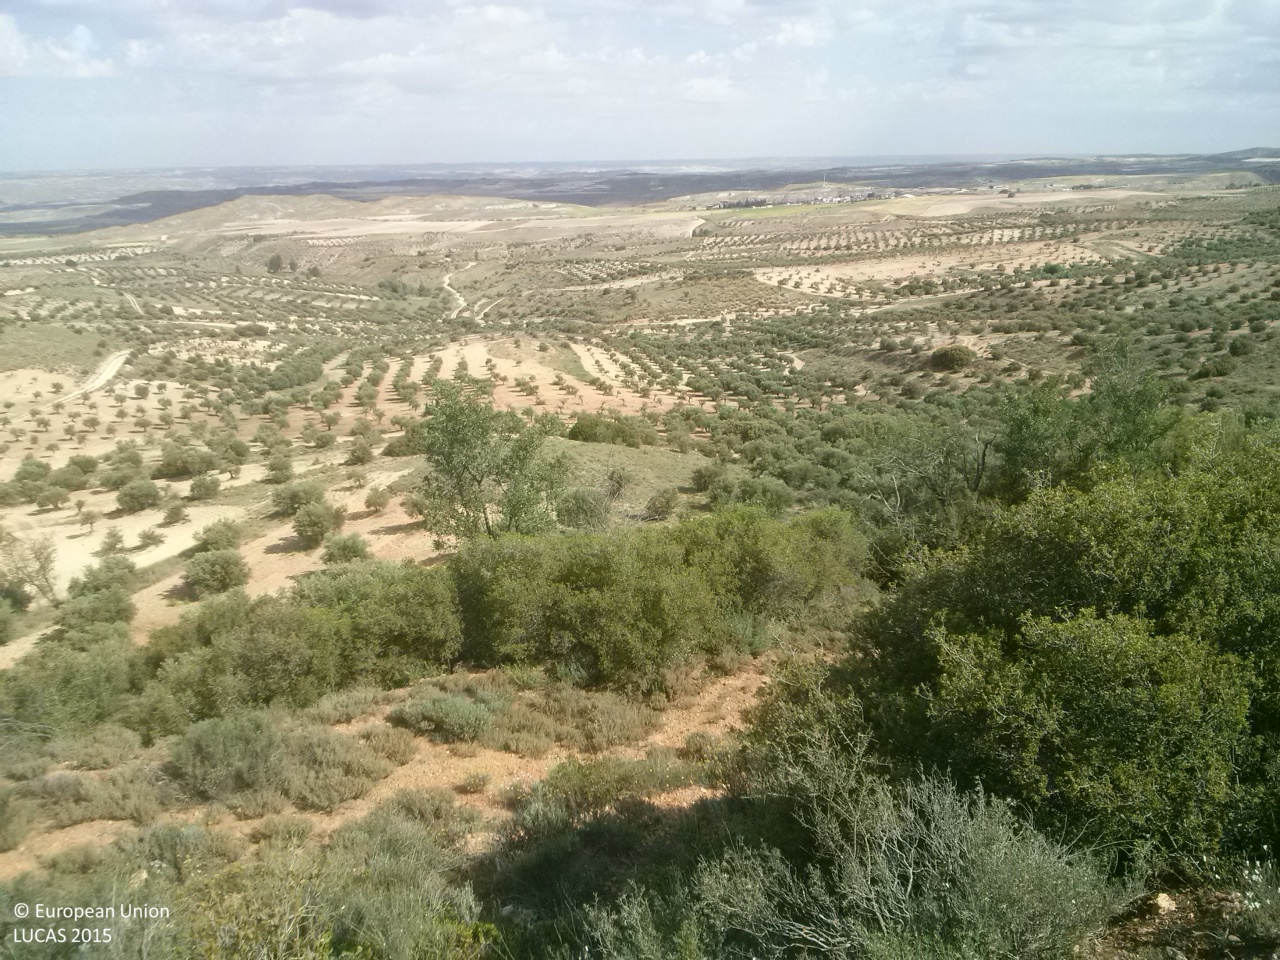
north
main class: Cropland
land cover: Olive groves
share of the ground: 10 - 25 %
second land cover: Shrubland without tree cover
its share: 50 - 75 %
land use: Abandoned areas
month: May
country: ES
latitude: 40.1613
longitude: -2.9044
